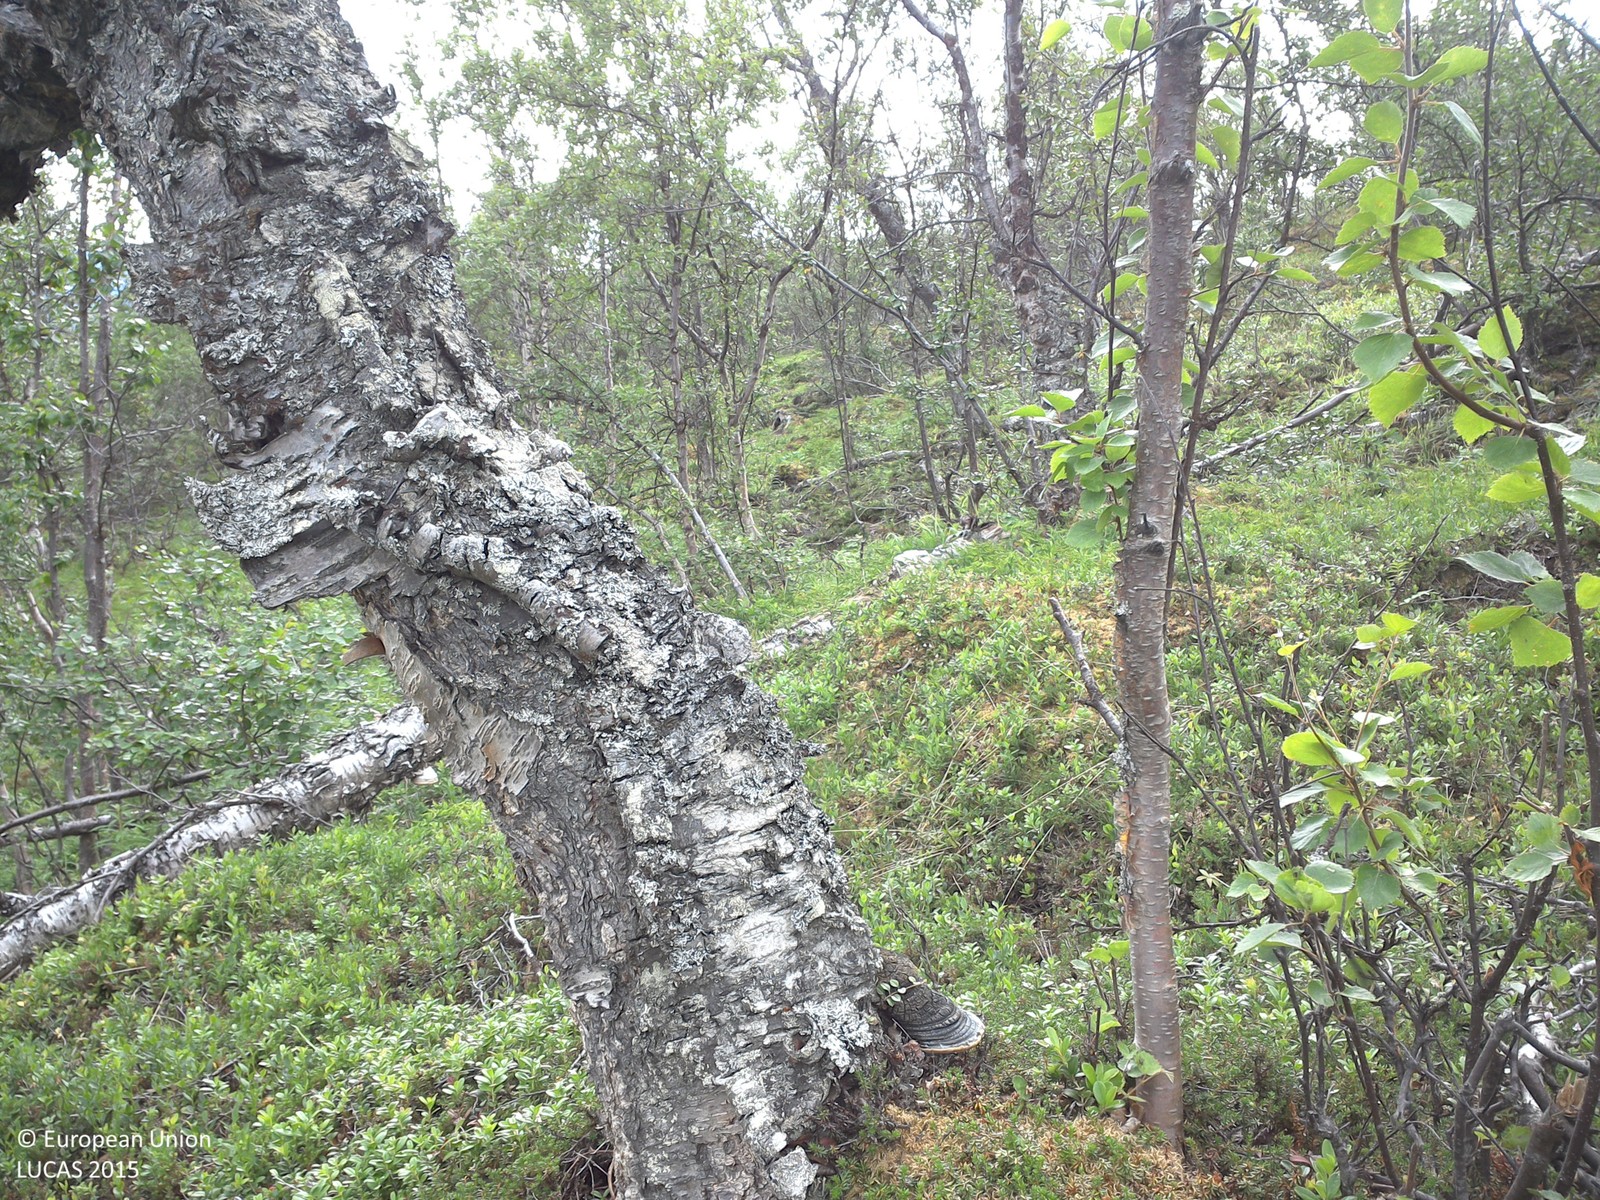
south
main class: Woodland
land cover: Broadleaved woodland
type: boreal forest
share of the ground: 25 - 50 %
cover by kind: shrubs 50 %, broadleaved forest trees 25 %, herbaceous plants 20 %, lichens and mosses 5 %
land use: Amenities, museums, leisure
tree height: > 5 m
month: August
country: SE
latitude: 68.3664
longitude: 18.7549
